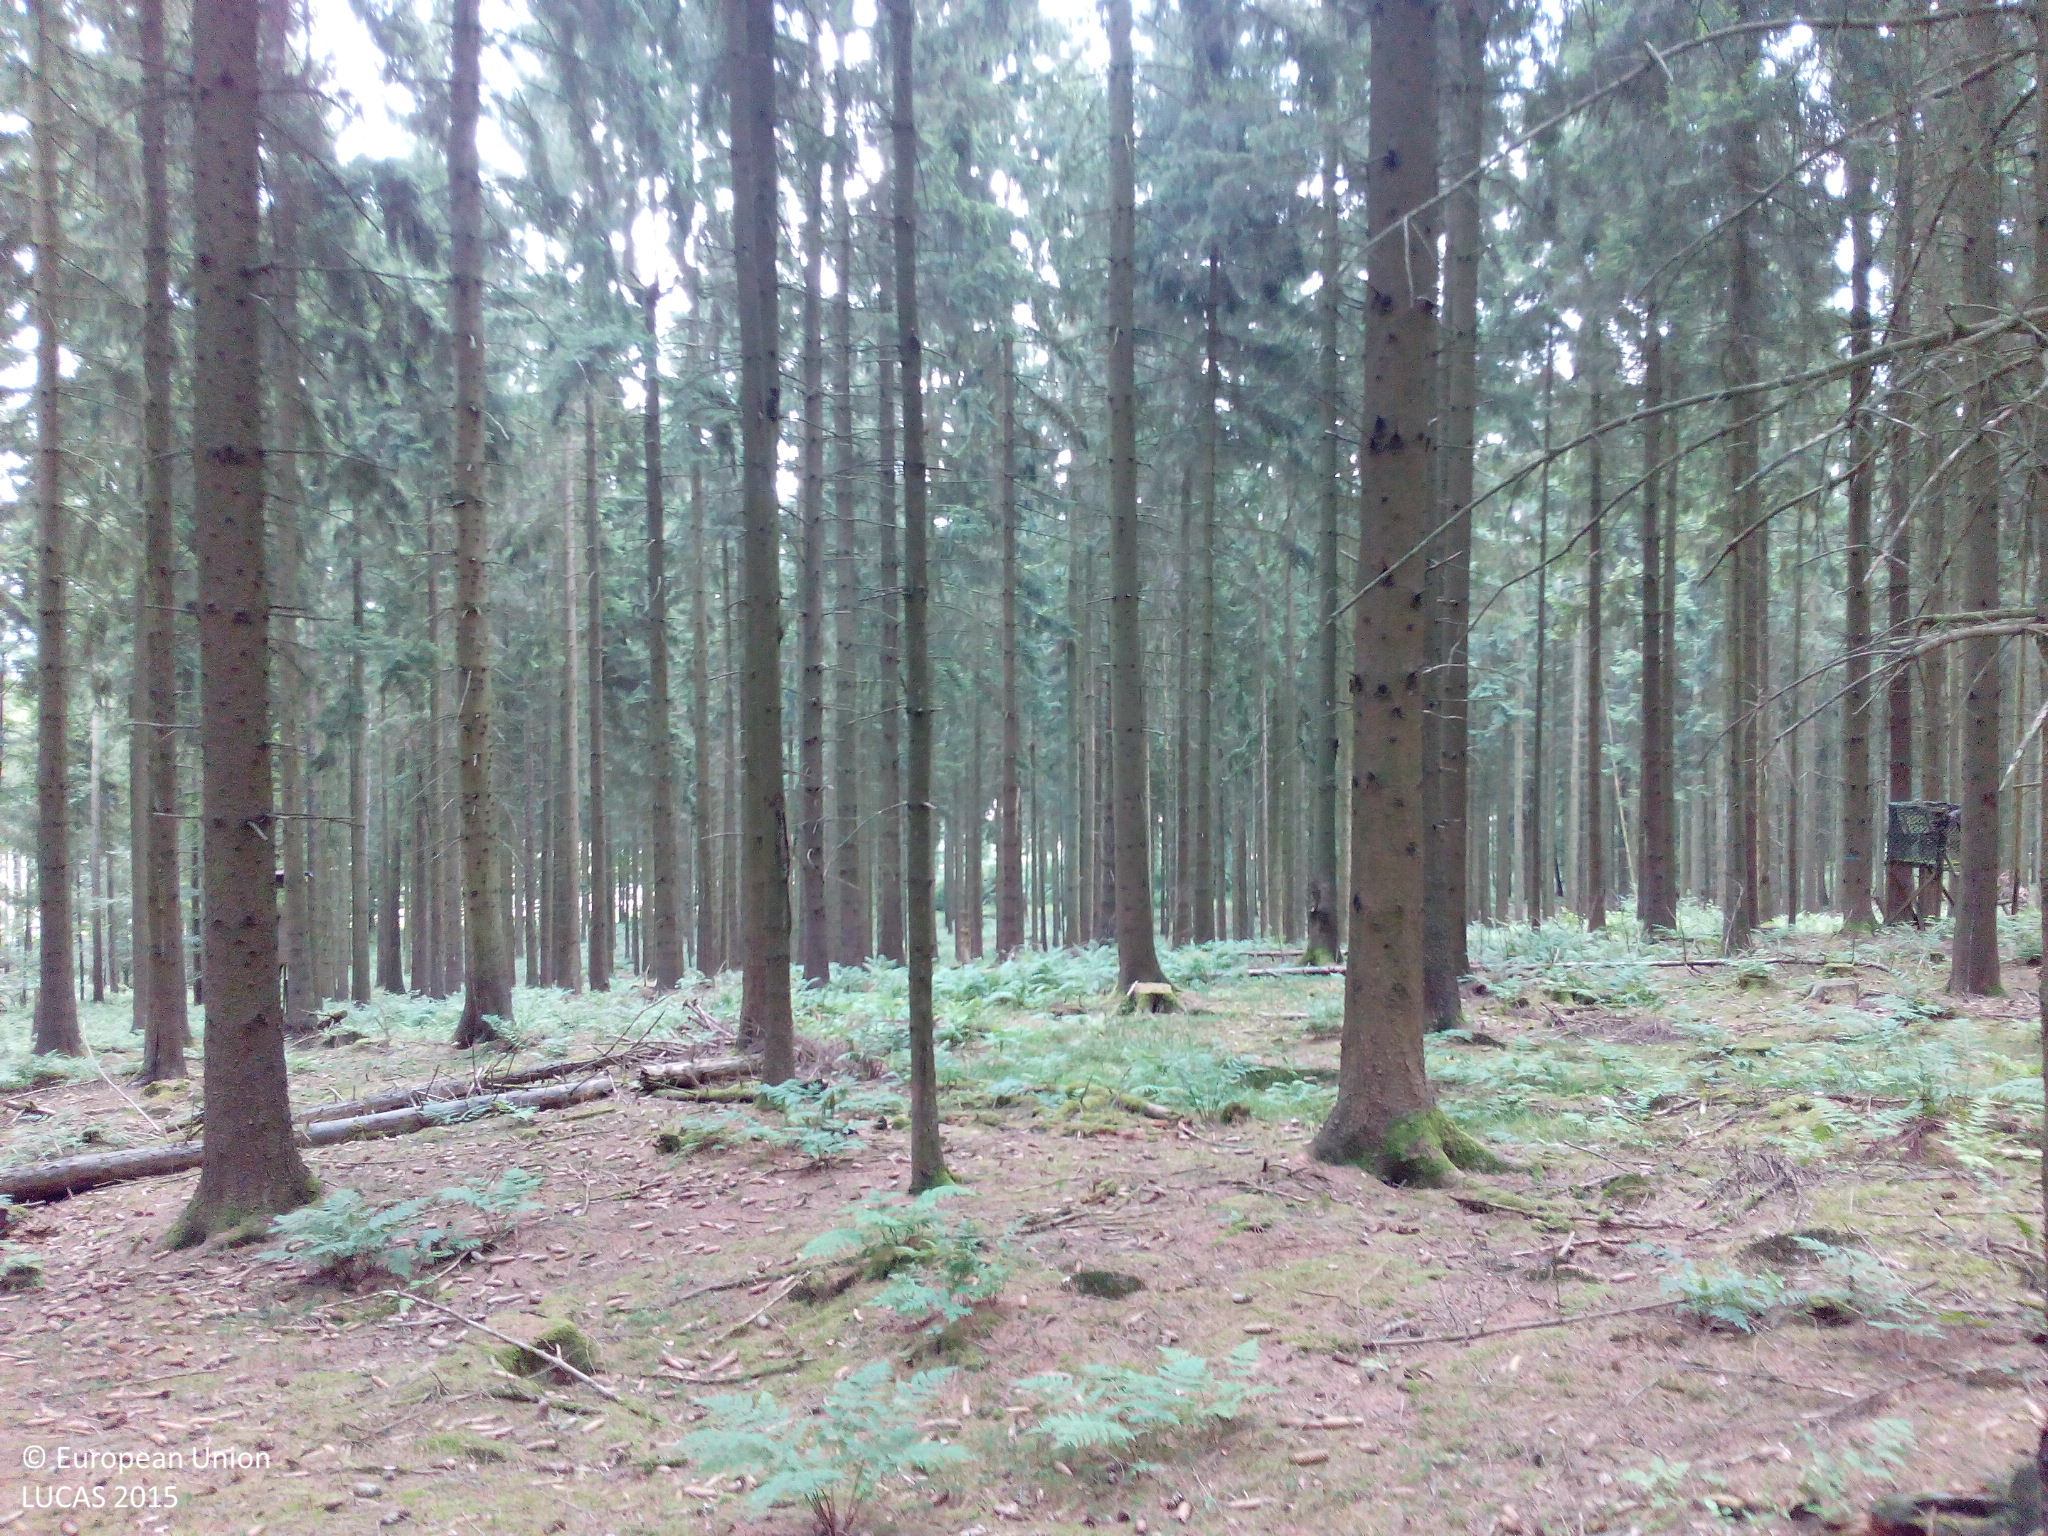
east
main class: Woodland
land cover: Spruce dominated coniferous woodland
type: hemiboreal forest and nemoral coniferous forest and mixed broadleaved-coniferous forest
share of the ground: > 75 %
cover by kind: coniferous forest trees 95 %, herbaceous plants 5 %
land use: Forestry
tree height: > 5 m
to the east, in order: Spruce dominated coniferous woodland; Tracks; Broadleaved woodland; Shruby margins; Tracks; Grass margins; Broadleaved woodland; Spontaneously vegetated surfaces
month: August
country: DE
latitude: 52.0158
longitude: 9.2863
